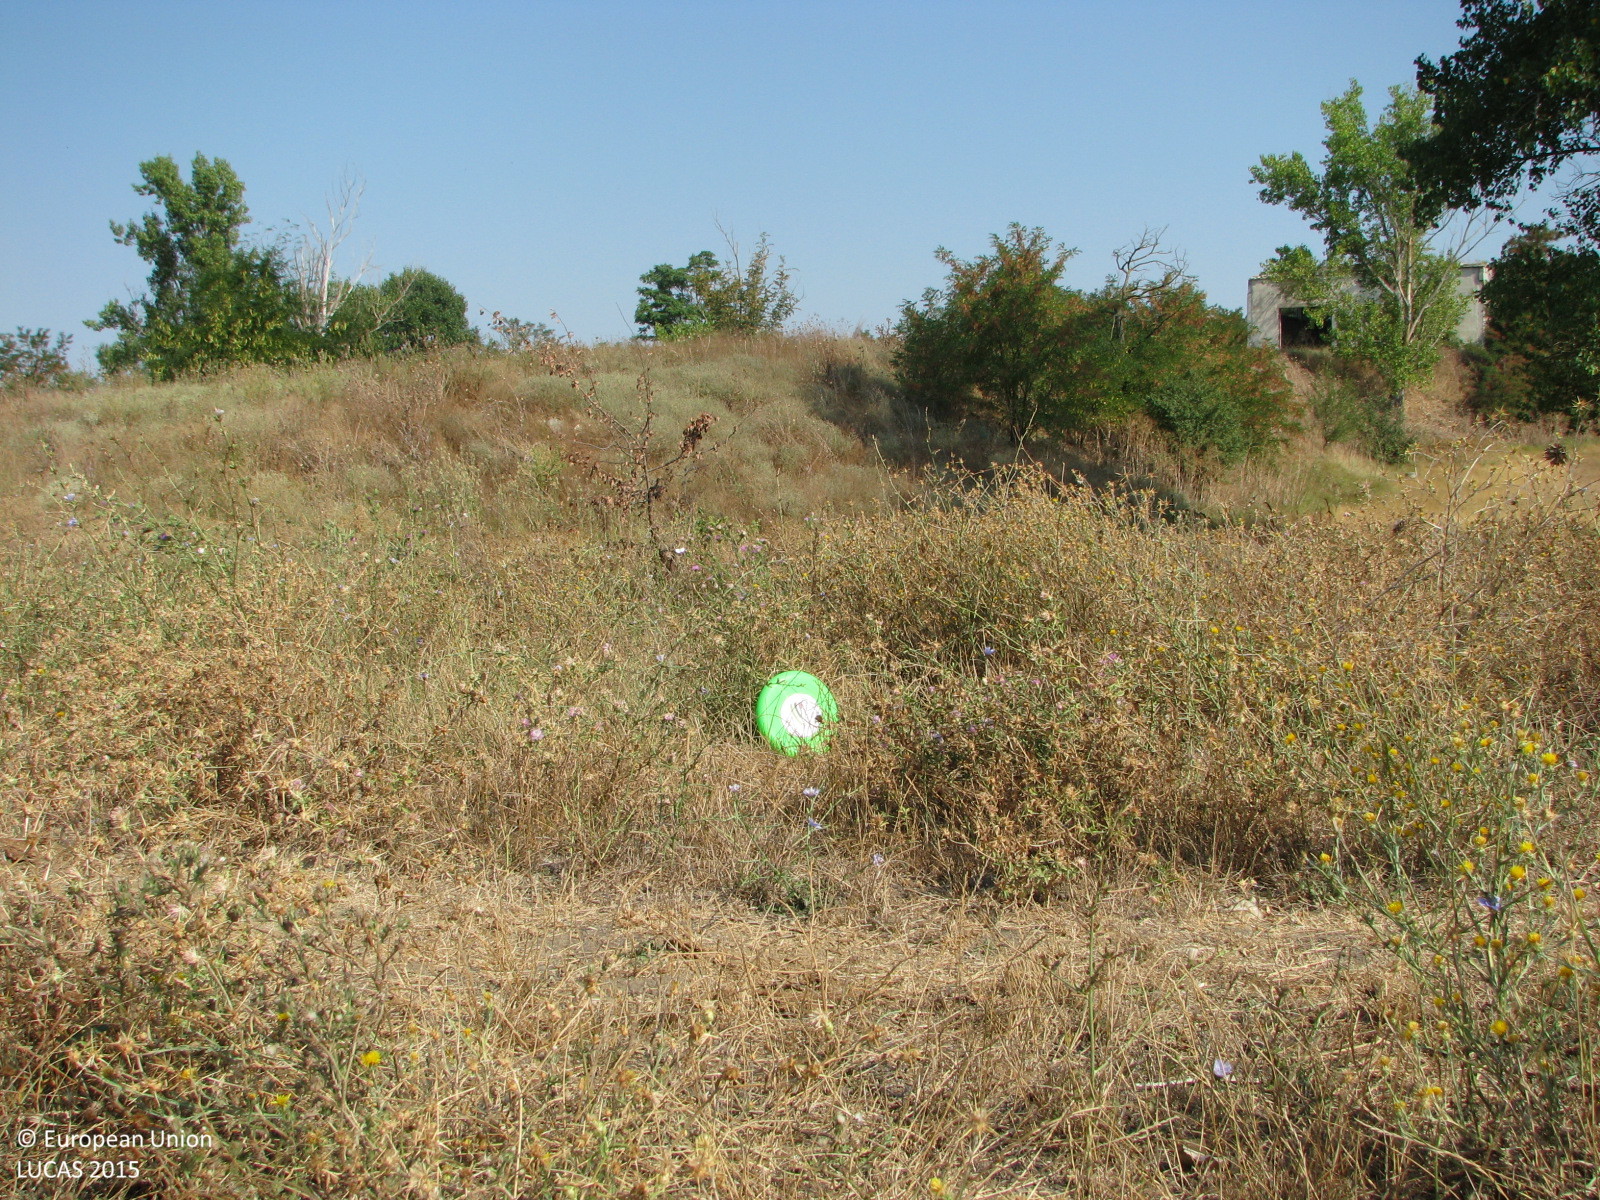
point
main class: Grassland
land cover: Grassland without tree/shrub cover
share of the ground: > 75 %
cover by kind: herbaceous plants 95 %, shrubs 5 %
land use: Agriculture (excluding fallow land and kitchen gardens)
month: August
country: BG
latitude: 42.1624
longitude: 26.5624
